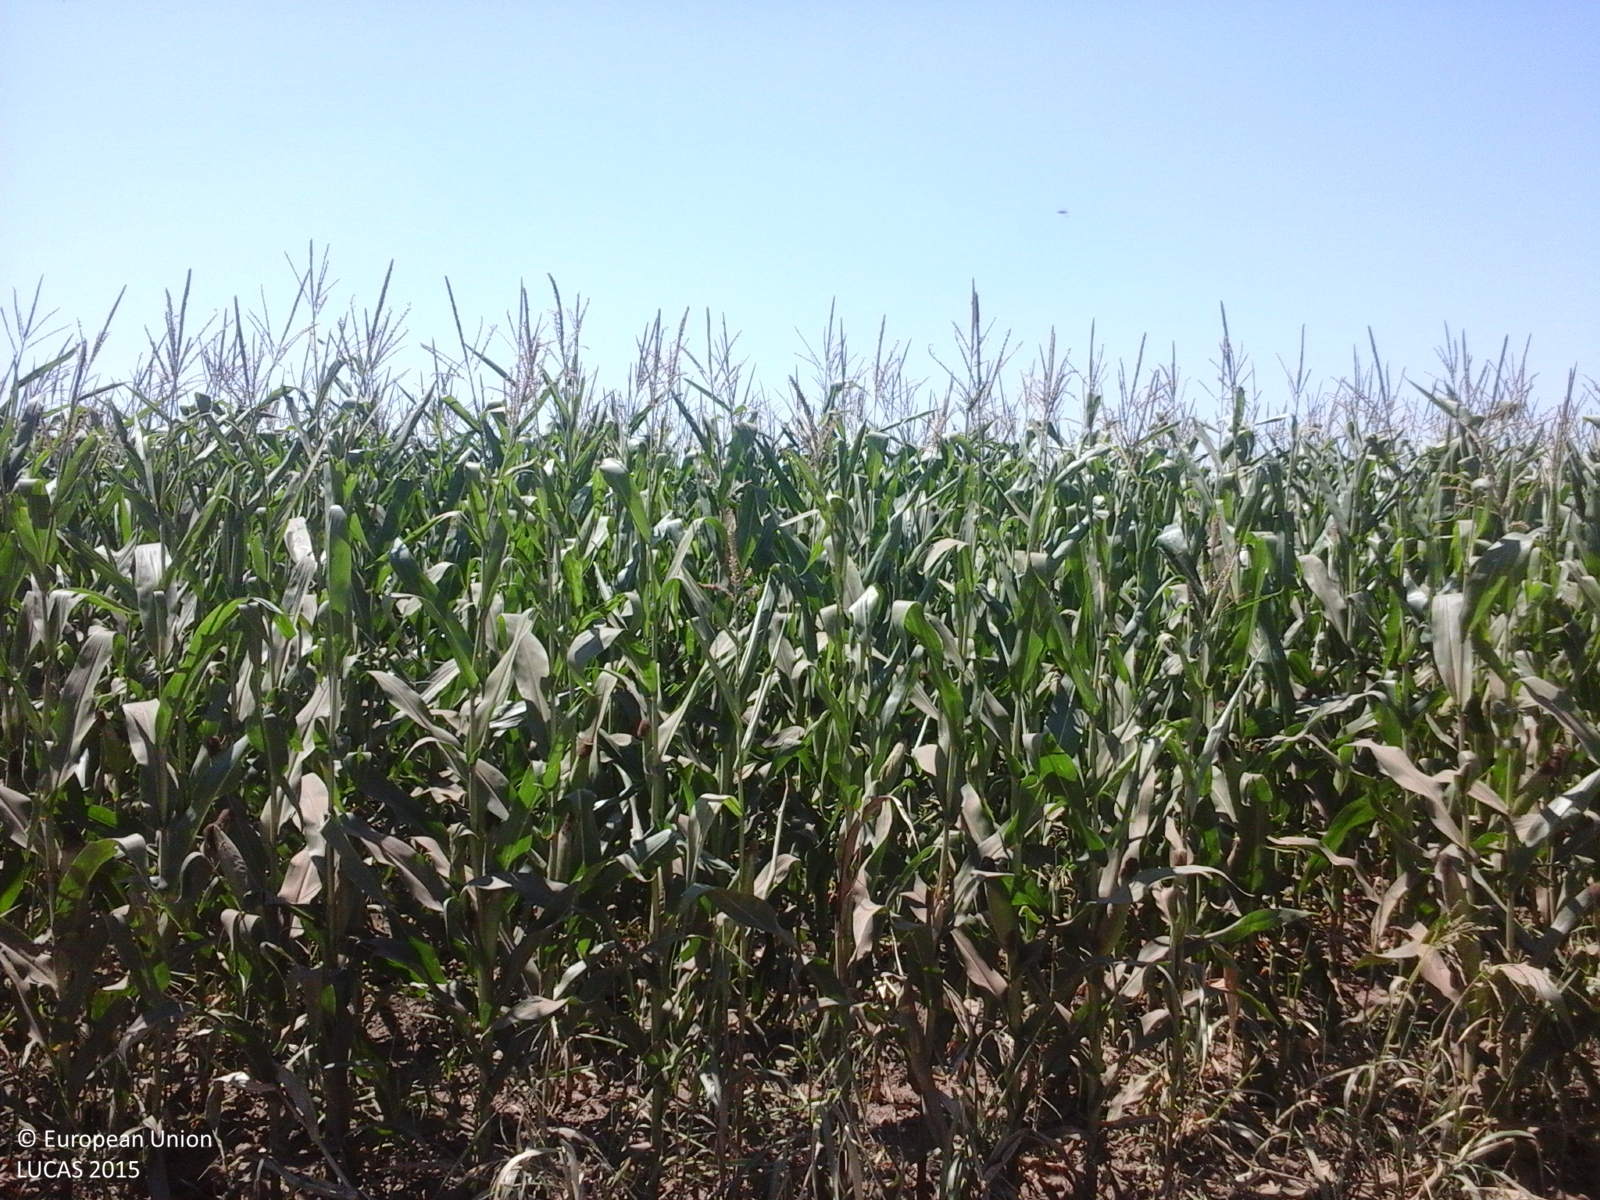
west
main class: Cropland
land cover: Maize
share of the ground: > 75 %
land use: Agriculture (excluding fallow land and kitchen gardens)
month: July
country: RO
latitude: 44.1510
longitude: 26.6569
